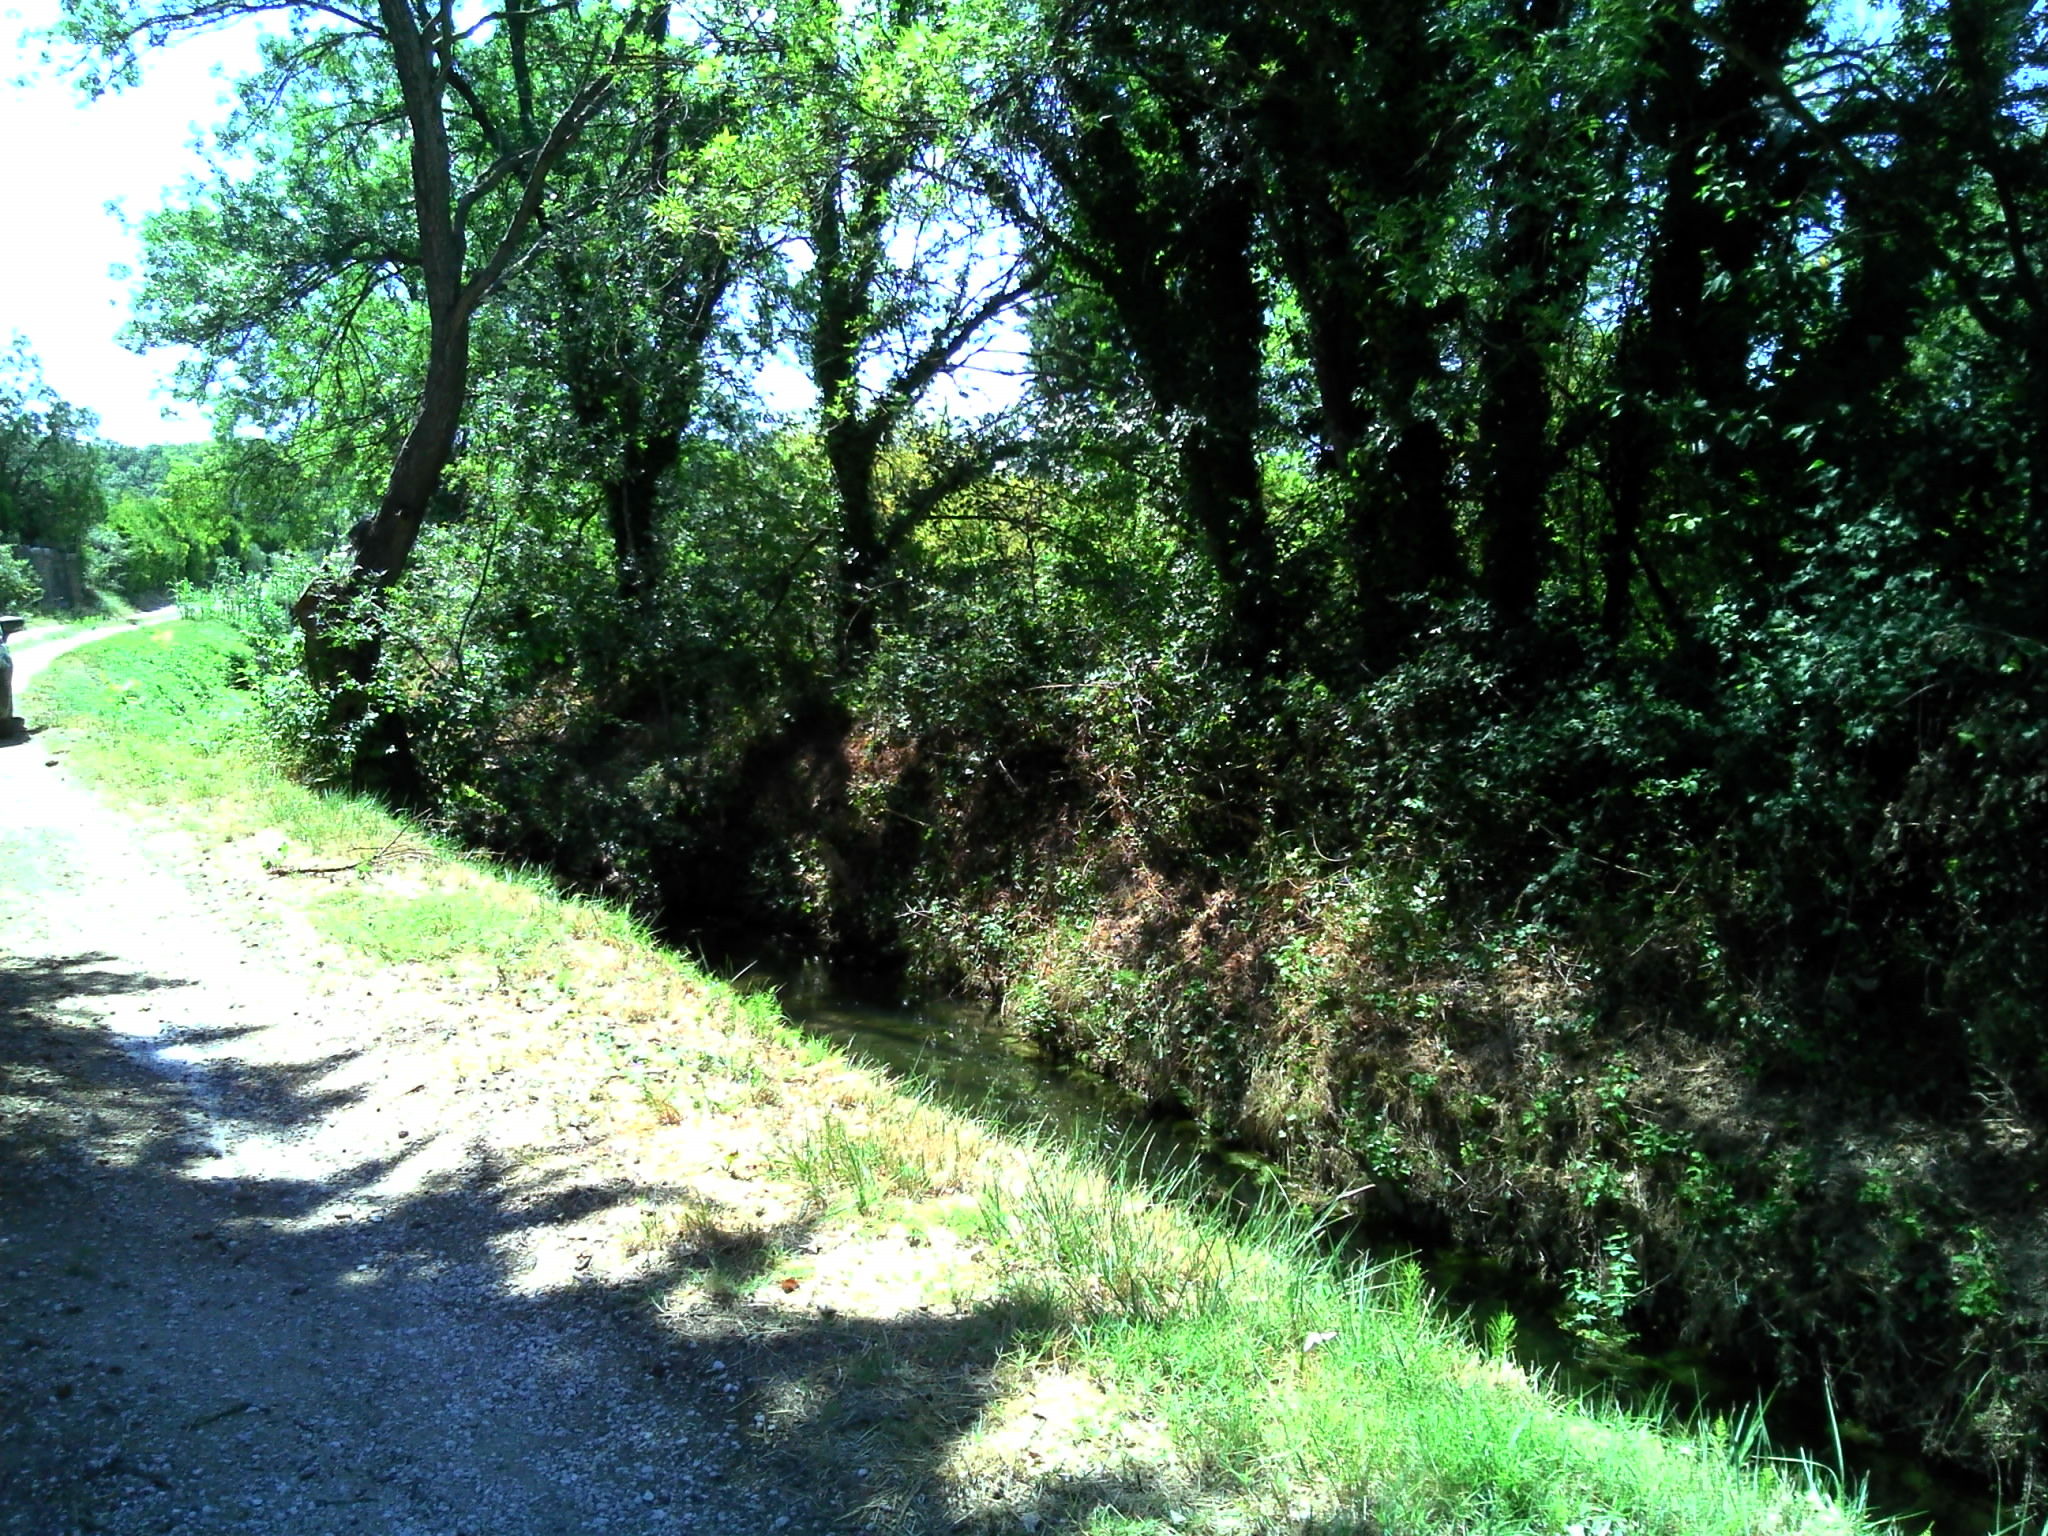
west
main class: Woodland
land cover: Broadleaved woodland
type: broadleaved evergreen forest
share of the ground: > 75 %
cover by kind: broadleaved forest trees 70 %, herbaceous plants 20 %, consolidated bare surface 10 %
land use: Semi-natural and natural areas not in use
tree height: > 5 m
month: August
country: FR
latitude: 43.9999
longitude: 4.7332
